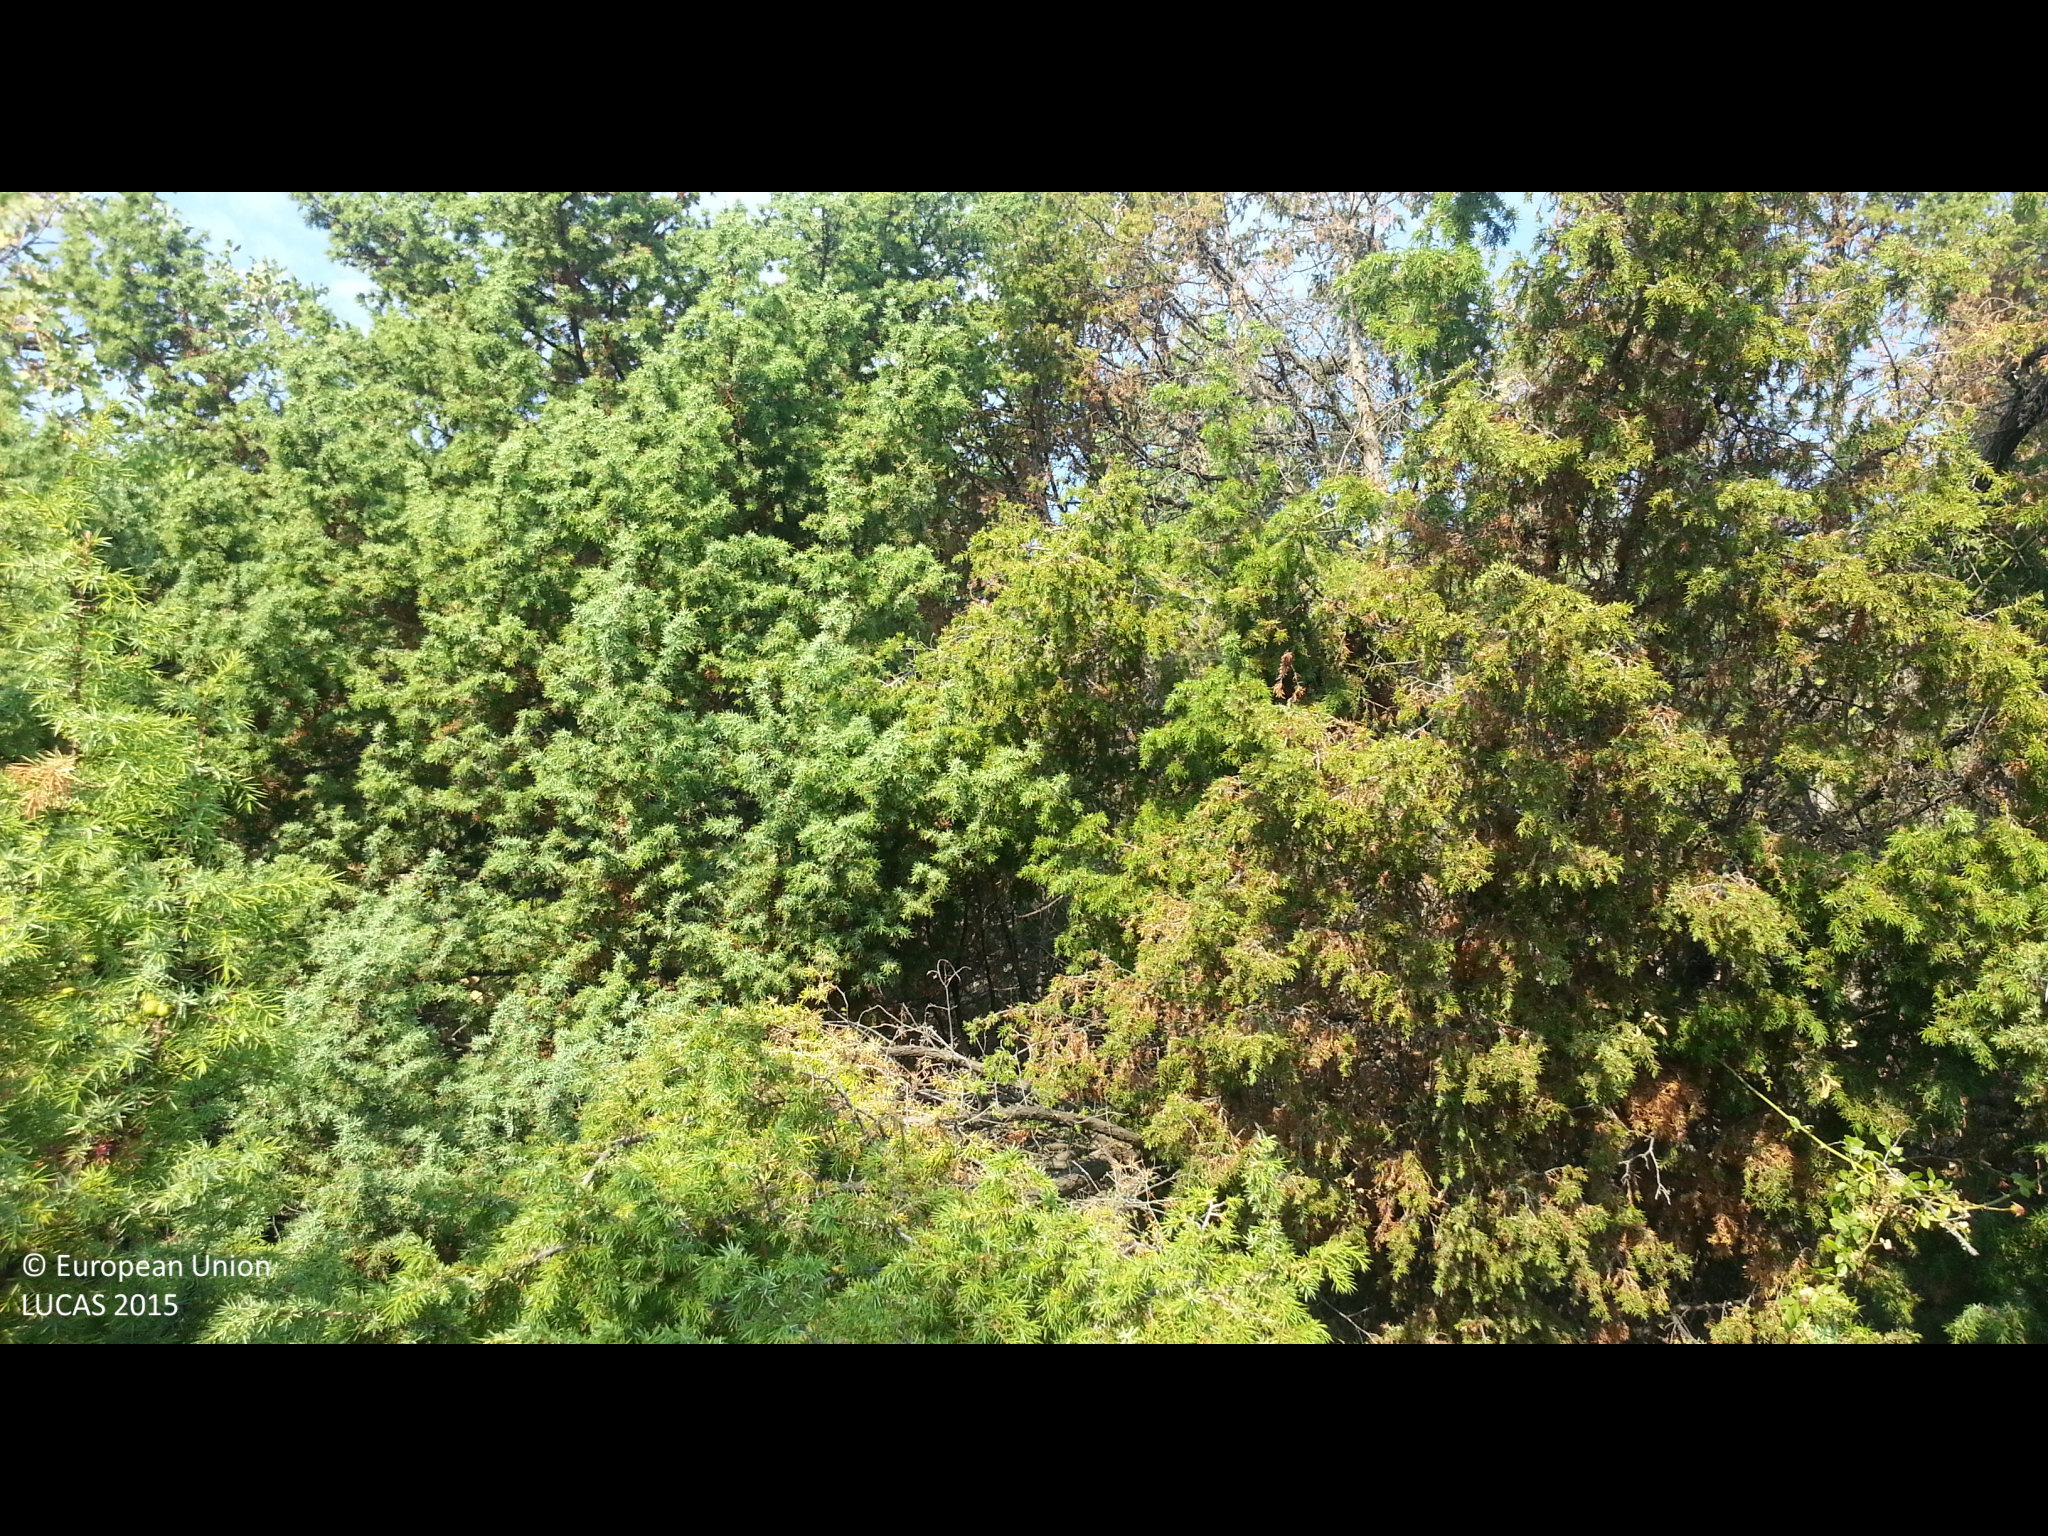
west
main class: Shrubland
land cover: Shrubland with sparse tree cover
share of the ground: > 75 %
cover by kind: shrubs 75 %, herbaceous plants 20 %, broadleaved forest trees 5 %
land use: Semi-natural and natural areas not in use
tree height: < 5 m
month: August
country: BG
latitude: 42.4233
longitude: 22.6502
